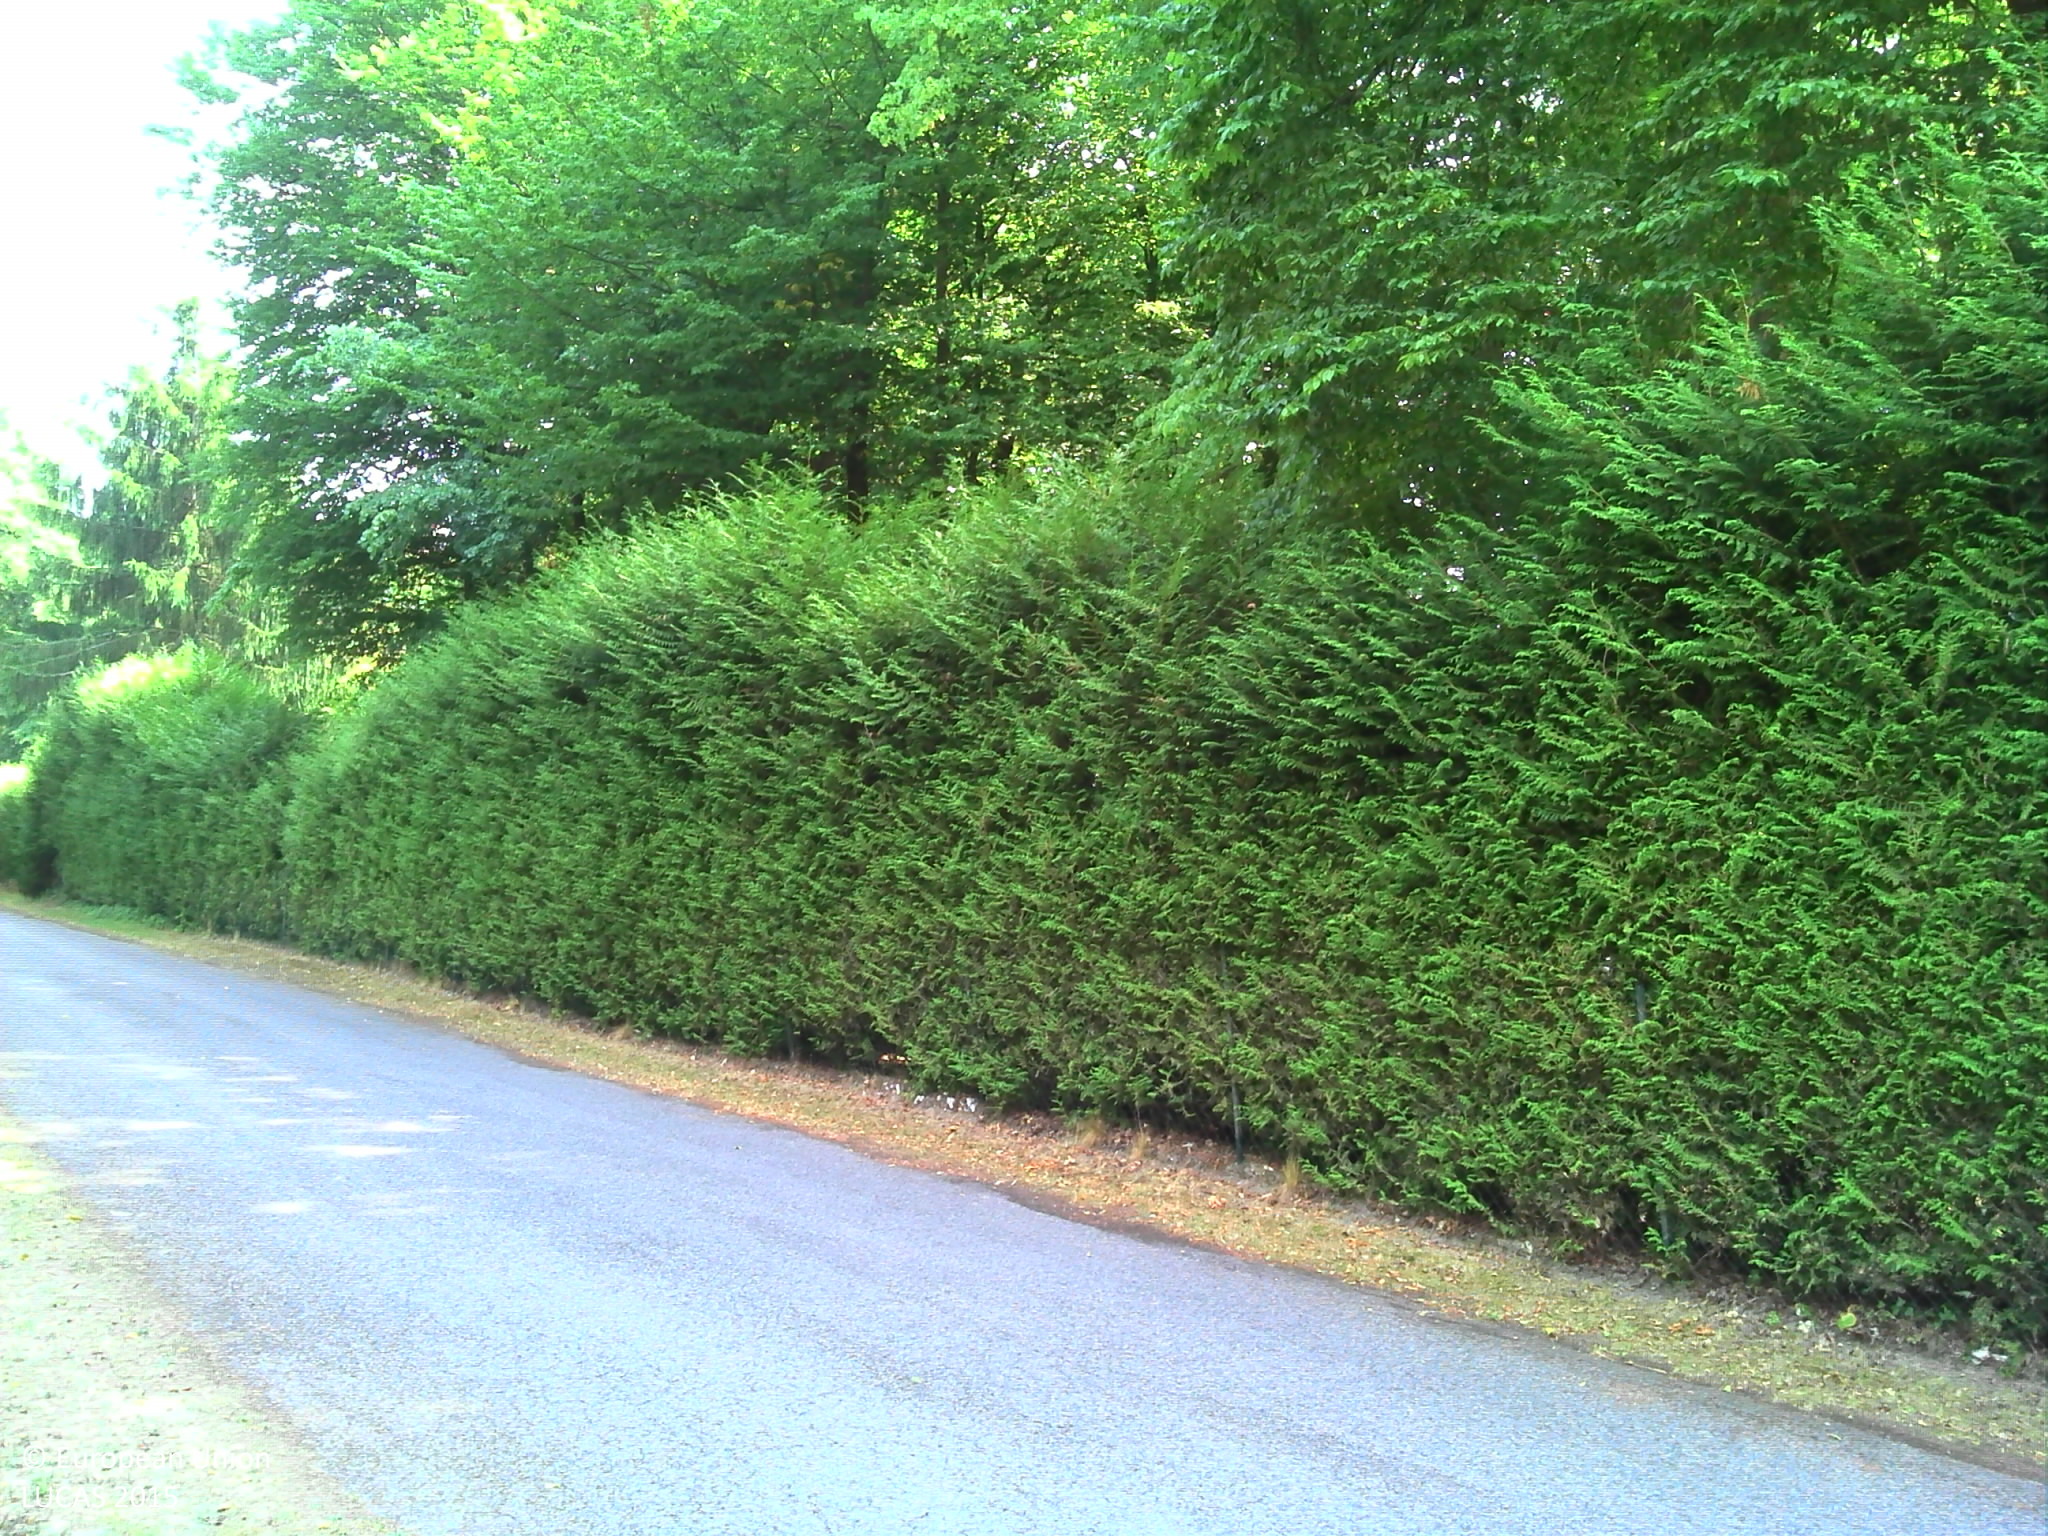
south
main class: Grassland
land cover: Grassland with sparse tree/shrub cover
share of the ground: > 75 %
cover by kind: herbaceous plants 95 %, broadleaved forest trees 5 %
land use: Residential
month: July
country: FR
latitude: 49.1719
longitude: 2.4027
